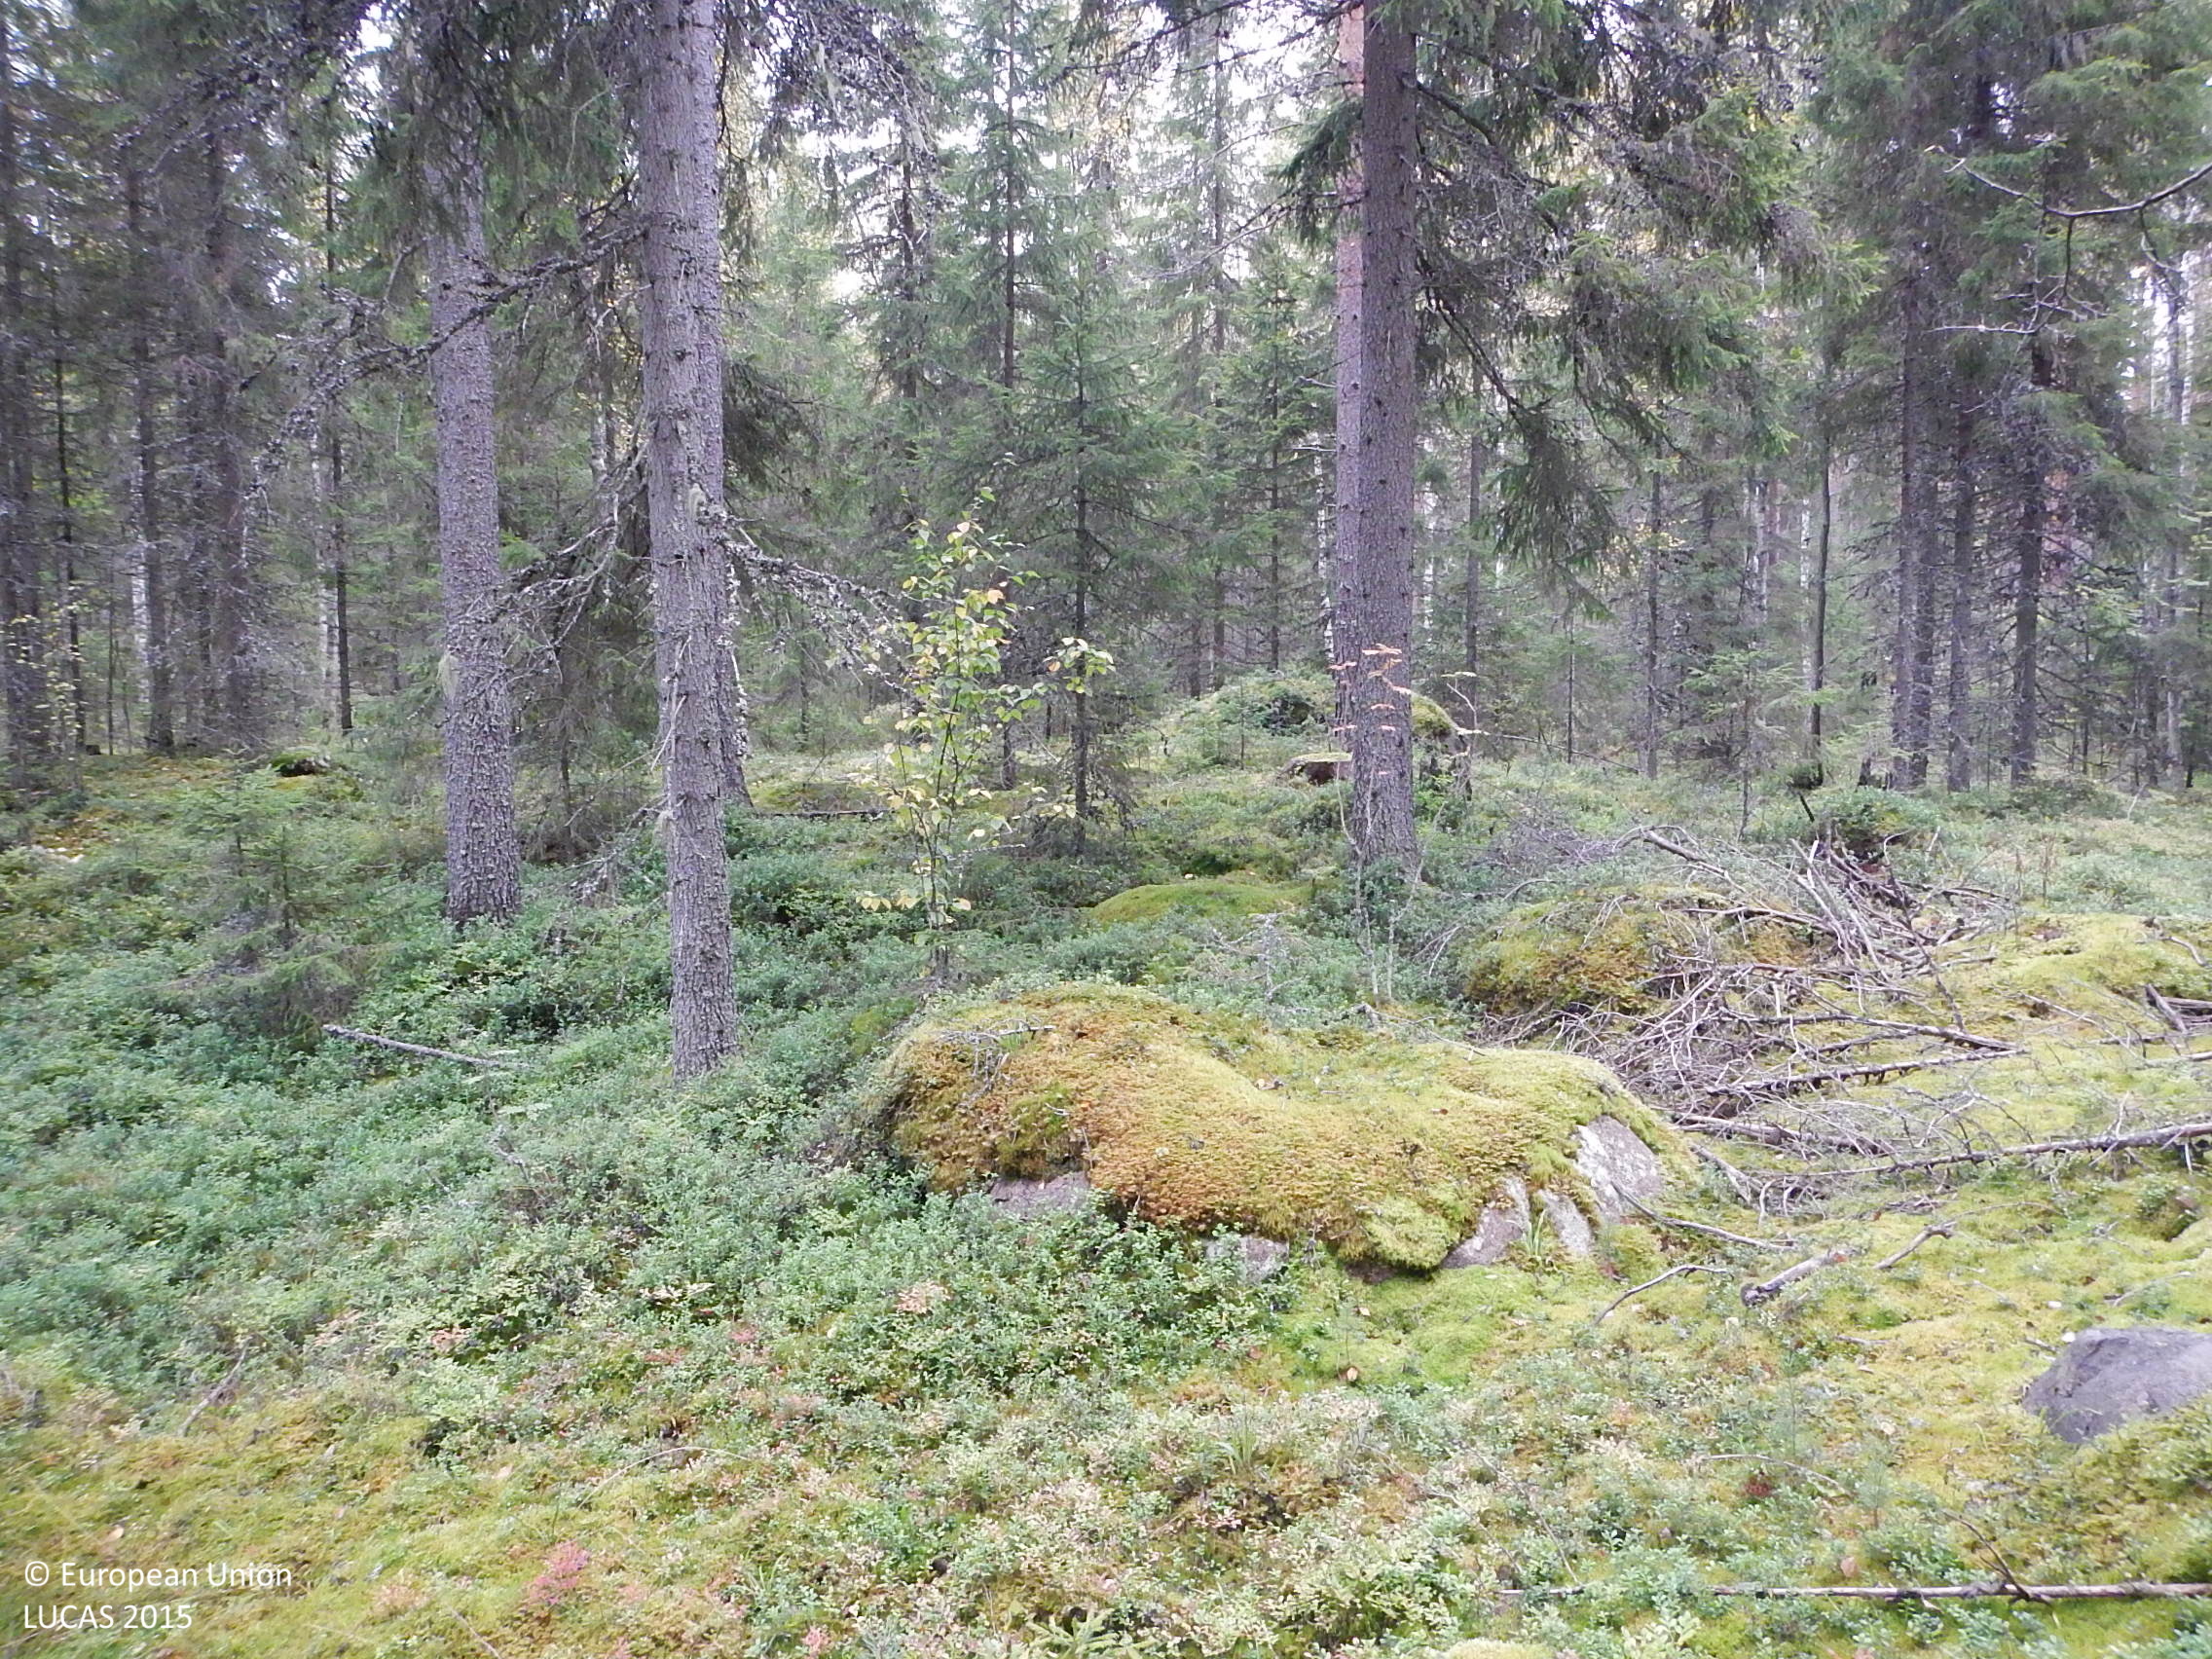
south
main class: Woodland
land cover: Spruce dominated coniferous woodland
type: boreal forest
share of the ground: 50 - 75 %
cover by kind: coniferous forest trees 40 %, shrubs 40 %, broadleaved forest trees 10 %, lichens and mosses 10 %
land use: Forestry
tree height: > 5 m
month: September
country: FI
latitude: 61.8426
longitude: 22.8117
